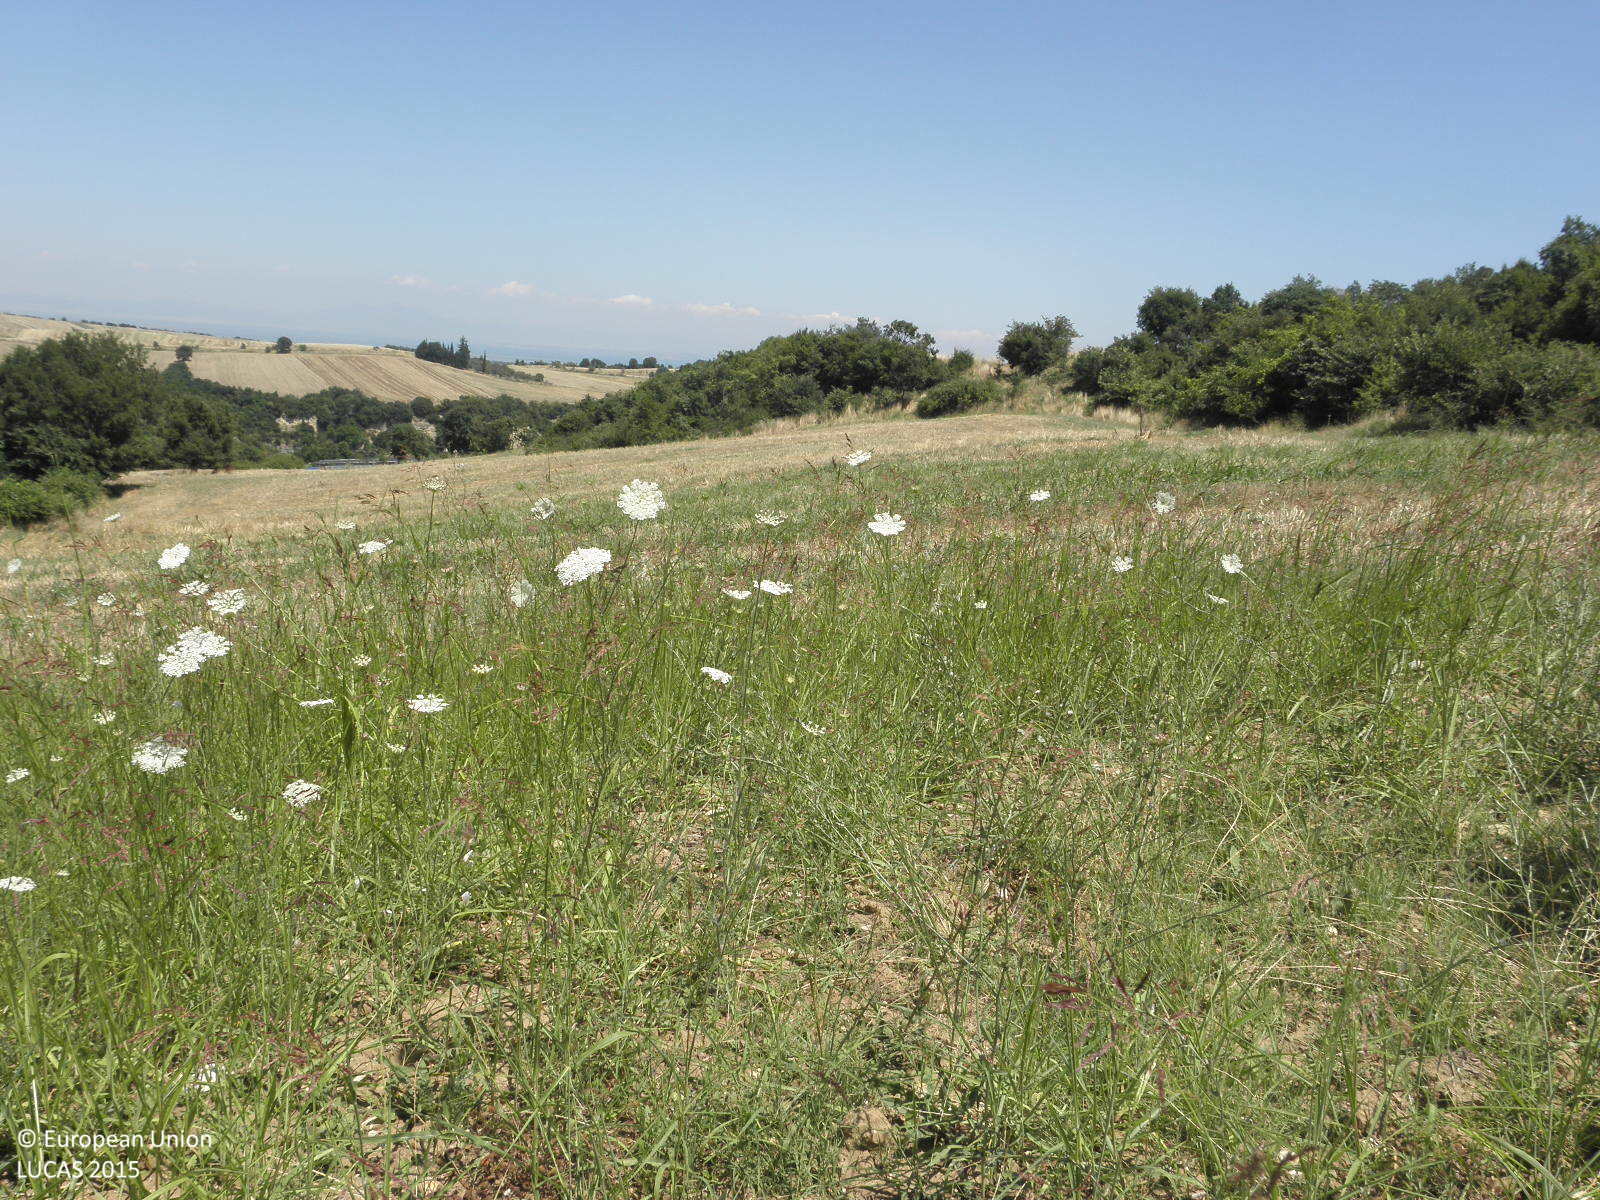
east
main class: Cropland
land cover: Olive groves
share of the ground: 50 - 75 %
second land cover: Spontaneously vegetated surfaces
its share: > 75 %
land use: Agriculture (excluding fallow land and kitchen gardens)
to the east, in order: Olive groves; Spontaneously vegetated surfaces; Common wheat; Shrubland without tree cover; Grass margins; Tracks; Broadleaved woodland; Shruby margins; Common wheat
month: July
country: GR
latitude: 40.4533
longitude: 22.4874
